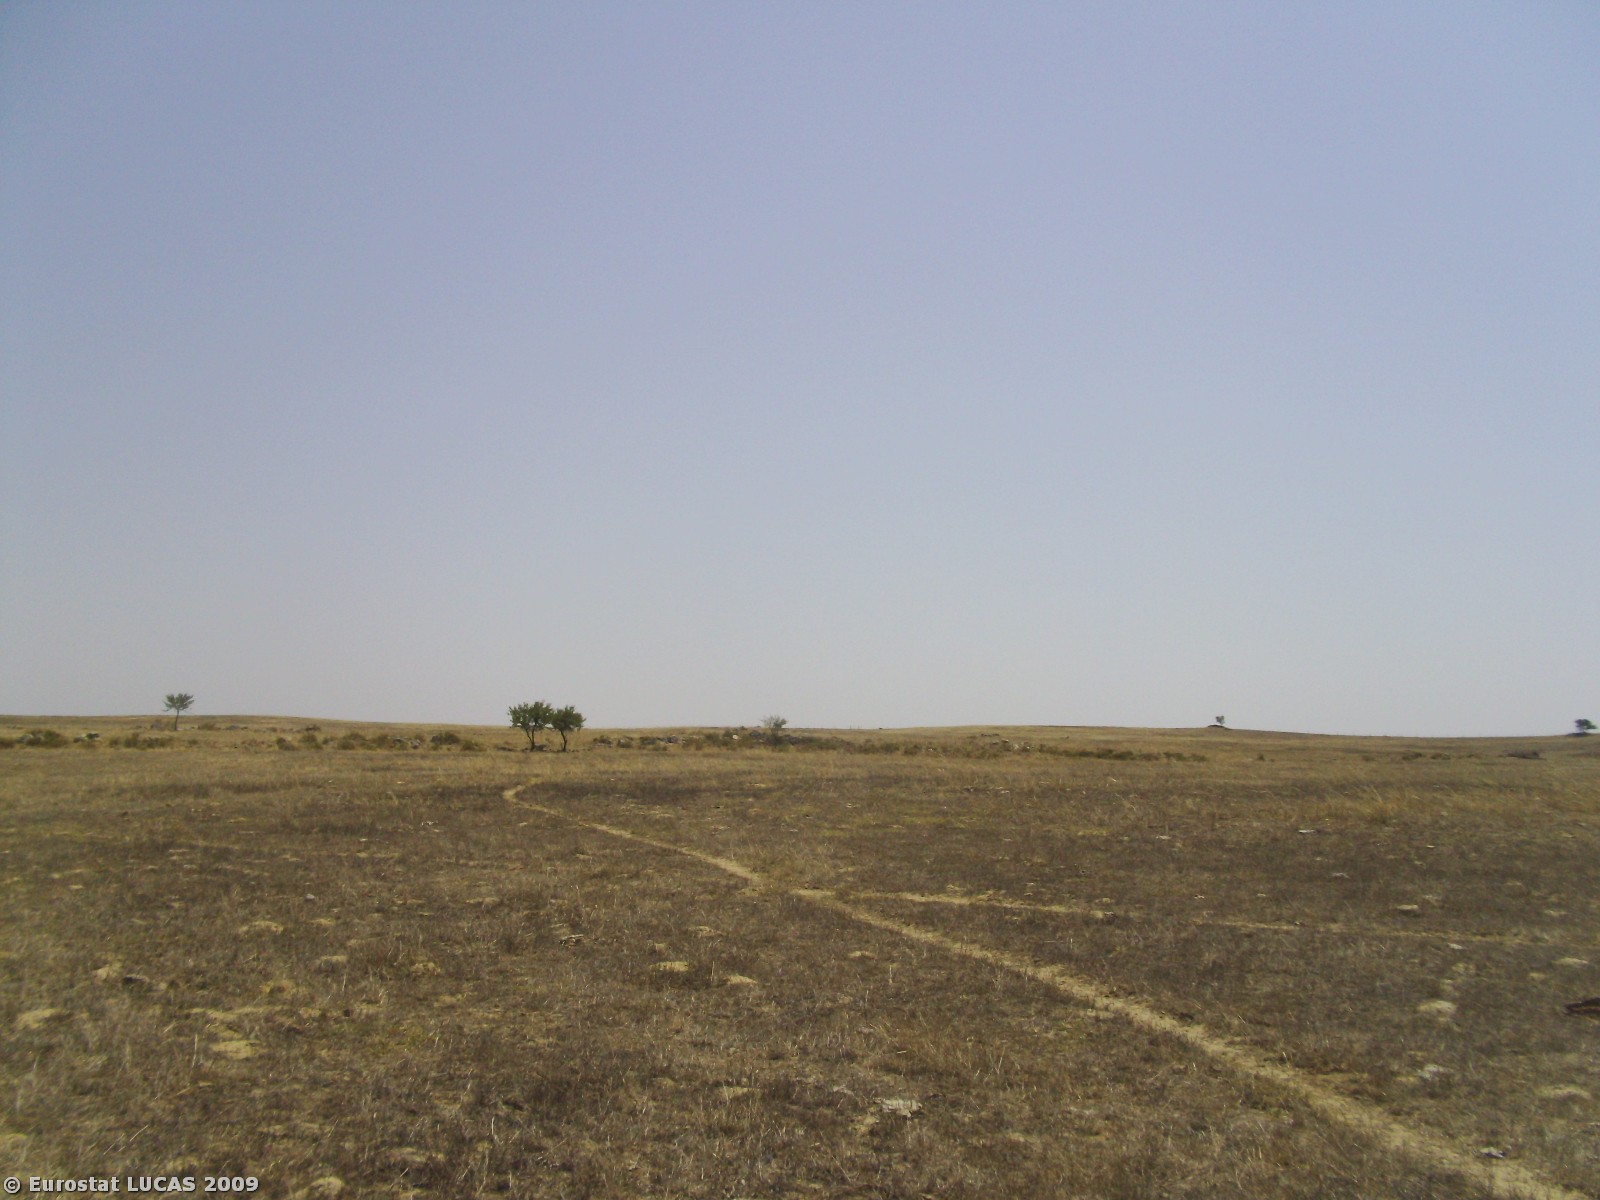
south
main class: Grassland
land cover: Grassland without tree/shrub cover
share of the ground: 25 - 50 %
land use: Agriculture (excluding fallow land and kitchen gardens)
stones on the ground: < 10 %
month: August
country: PT
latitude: 38.4278
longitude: -8.0590
